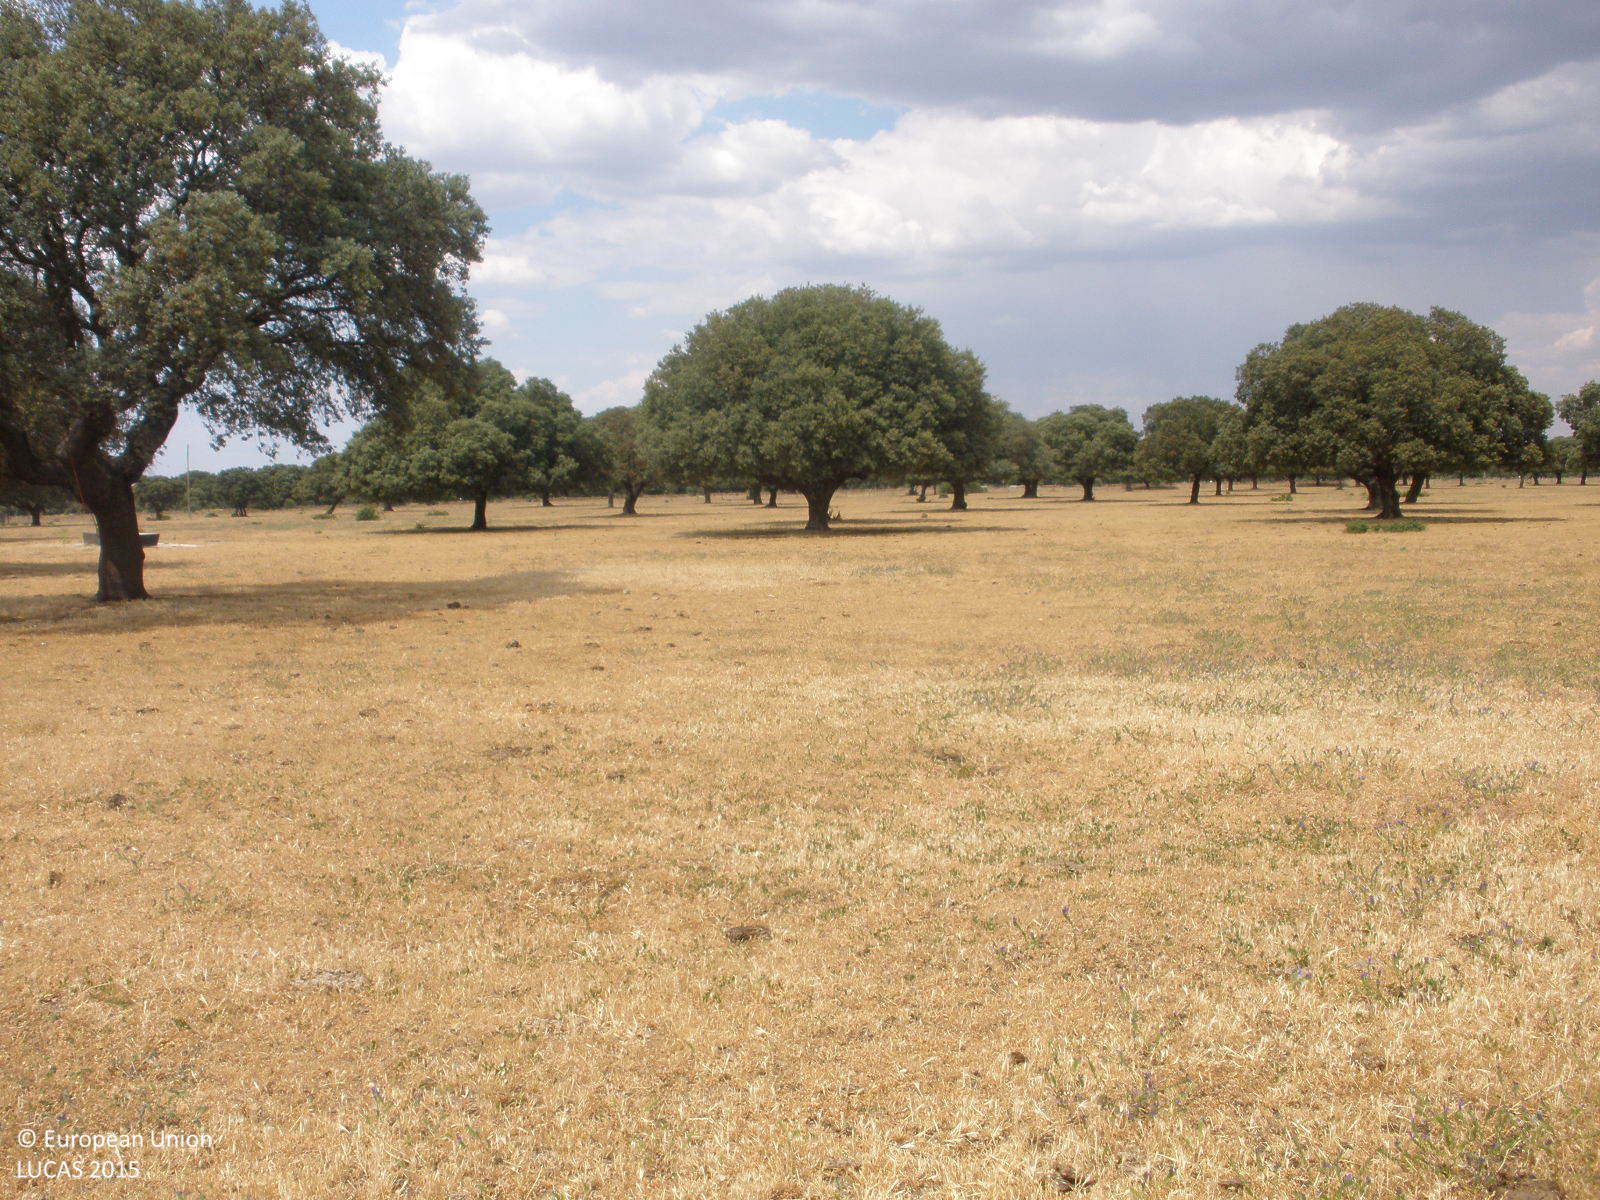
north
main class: Woodland
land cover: Broadleaved woodland
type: broadleaved evergreen forest
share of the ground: 10 - 25 %
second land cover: Grassland without tree/shrub cover
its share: > 75 %
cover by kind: herbaceous plants 90 %, broadleaved forest trees 10 %
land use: Forestry
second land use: Agriculture (excluding fallow land and kitchen gardens)
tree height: > 5 m
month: June
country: ES
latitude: 40.6723
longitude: -6.2325
